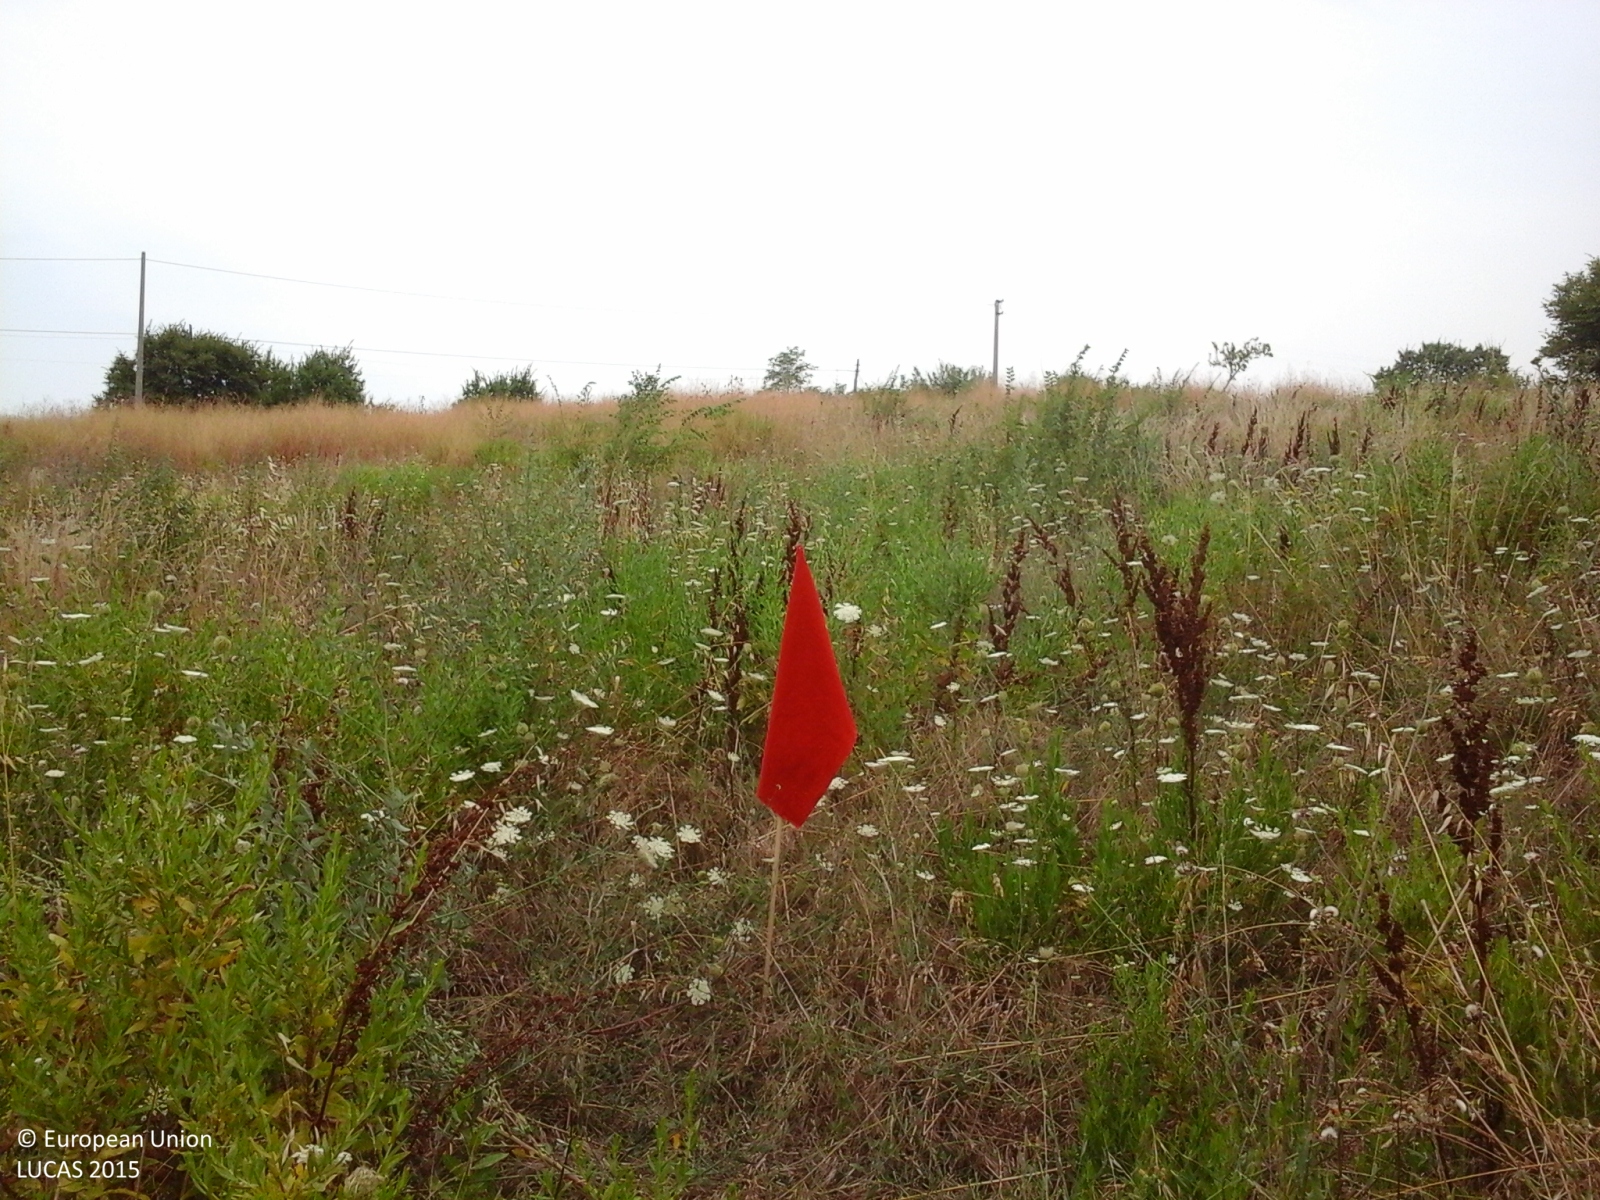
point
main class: Grassland
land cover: Spontaneously vegetated surfaces
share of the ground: > 75 %
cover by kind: herbaceous plants 95 %, shrubs 5 %
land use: Fallow land
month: August
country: IT
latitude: 43.4998
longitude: 13.4174
